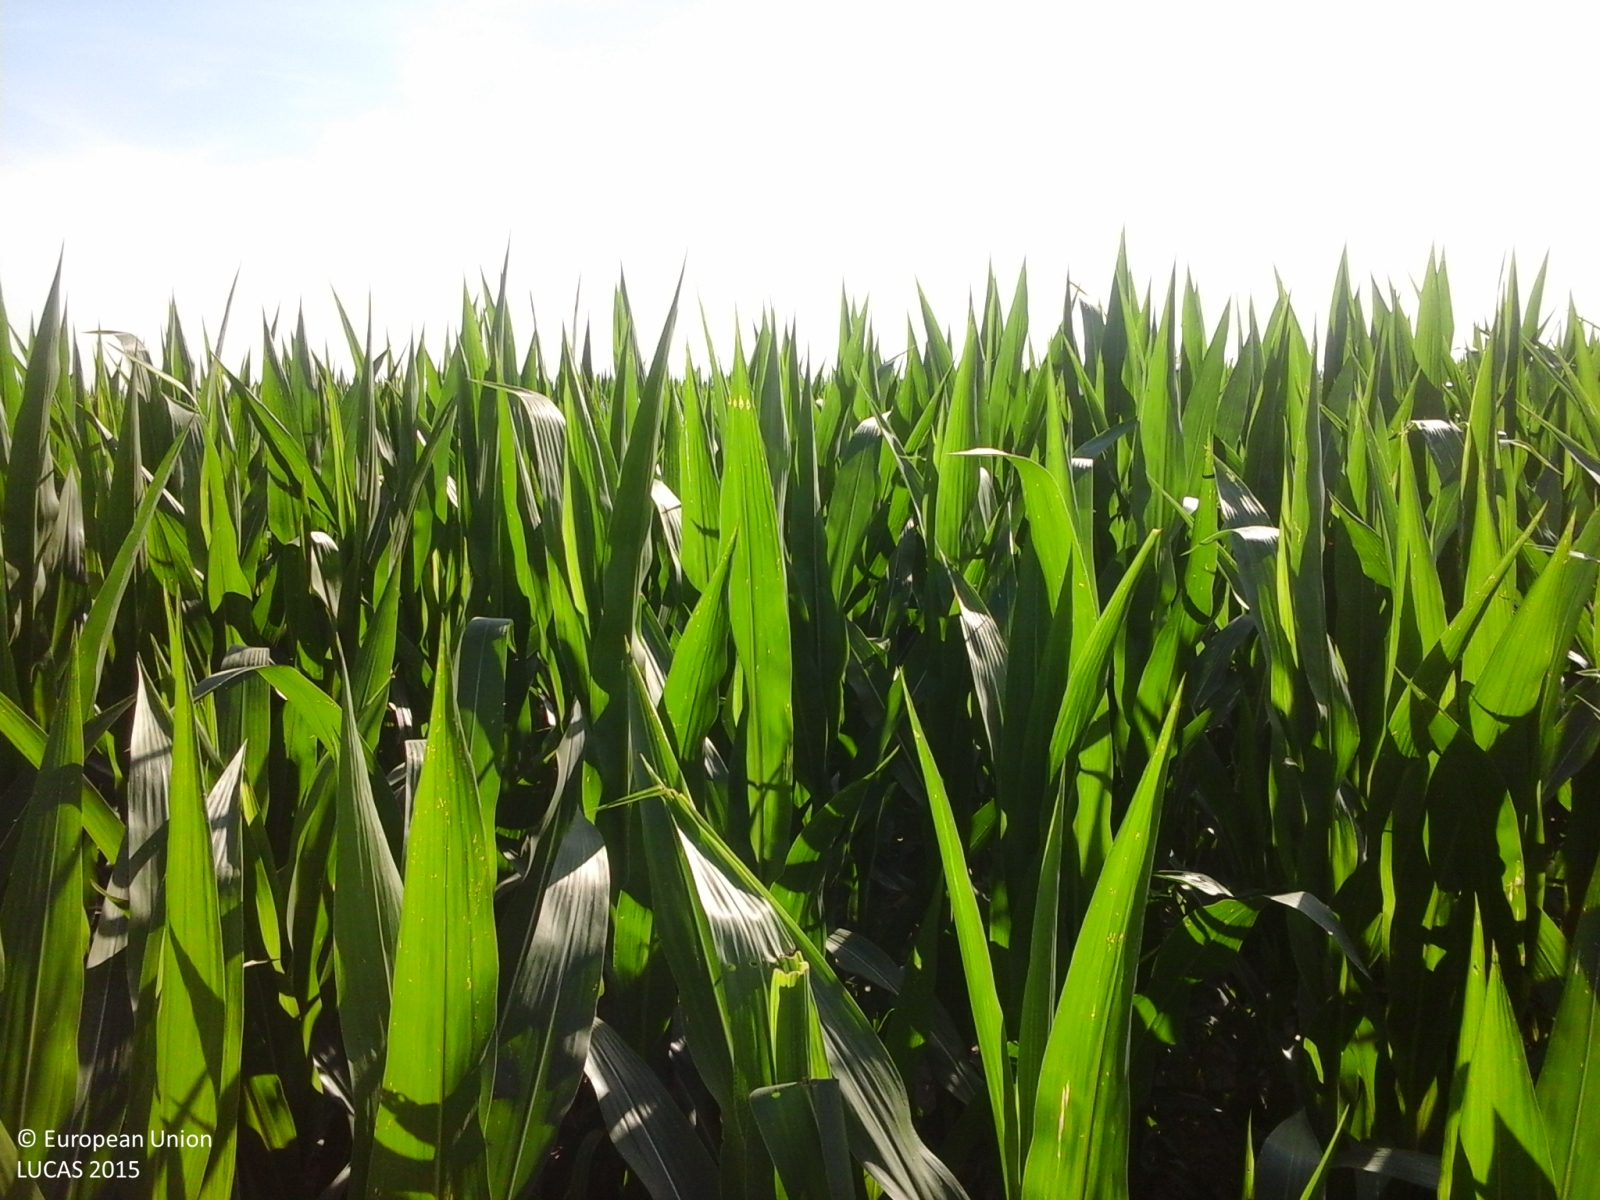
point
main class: Cropland
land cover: Maize
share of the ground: > 75 %
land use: Agriculture (excluding fallow land and kitchen gardens)
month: June
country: IT
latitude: 45.1161
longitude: 8.5662
